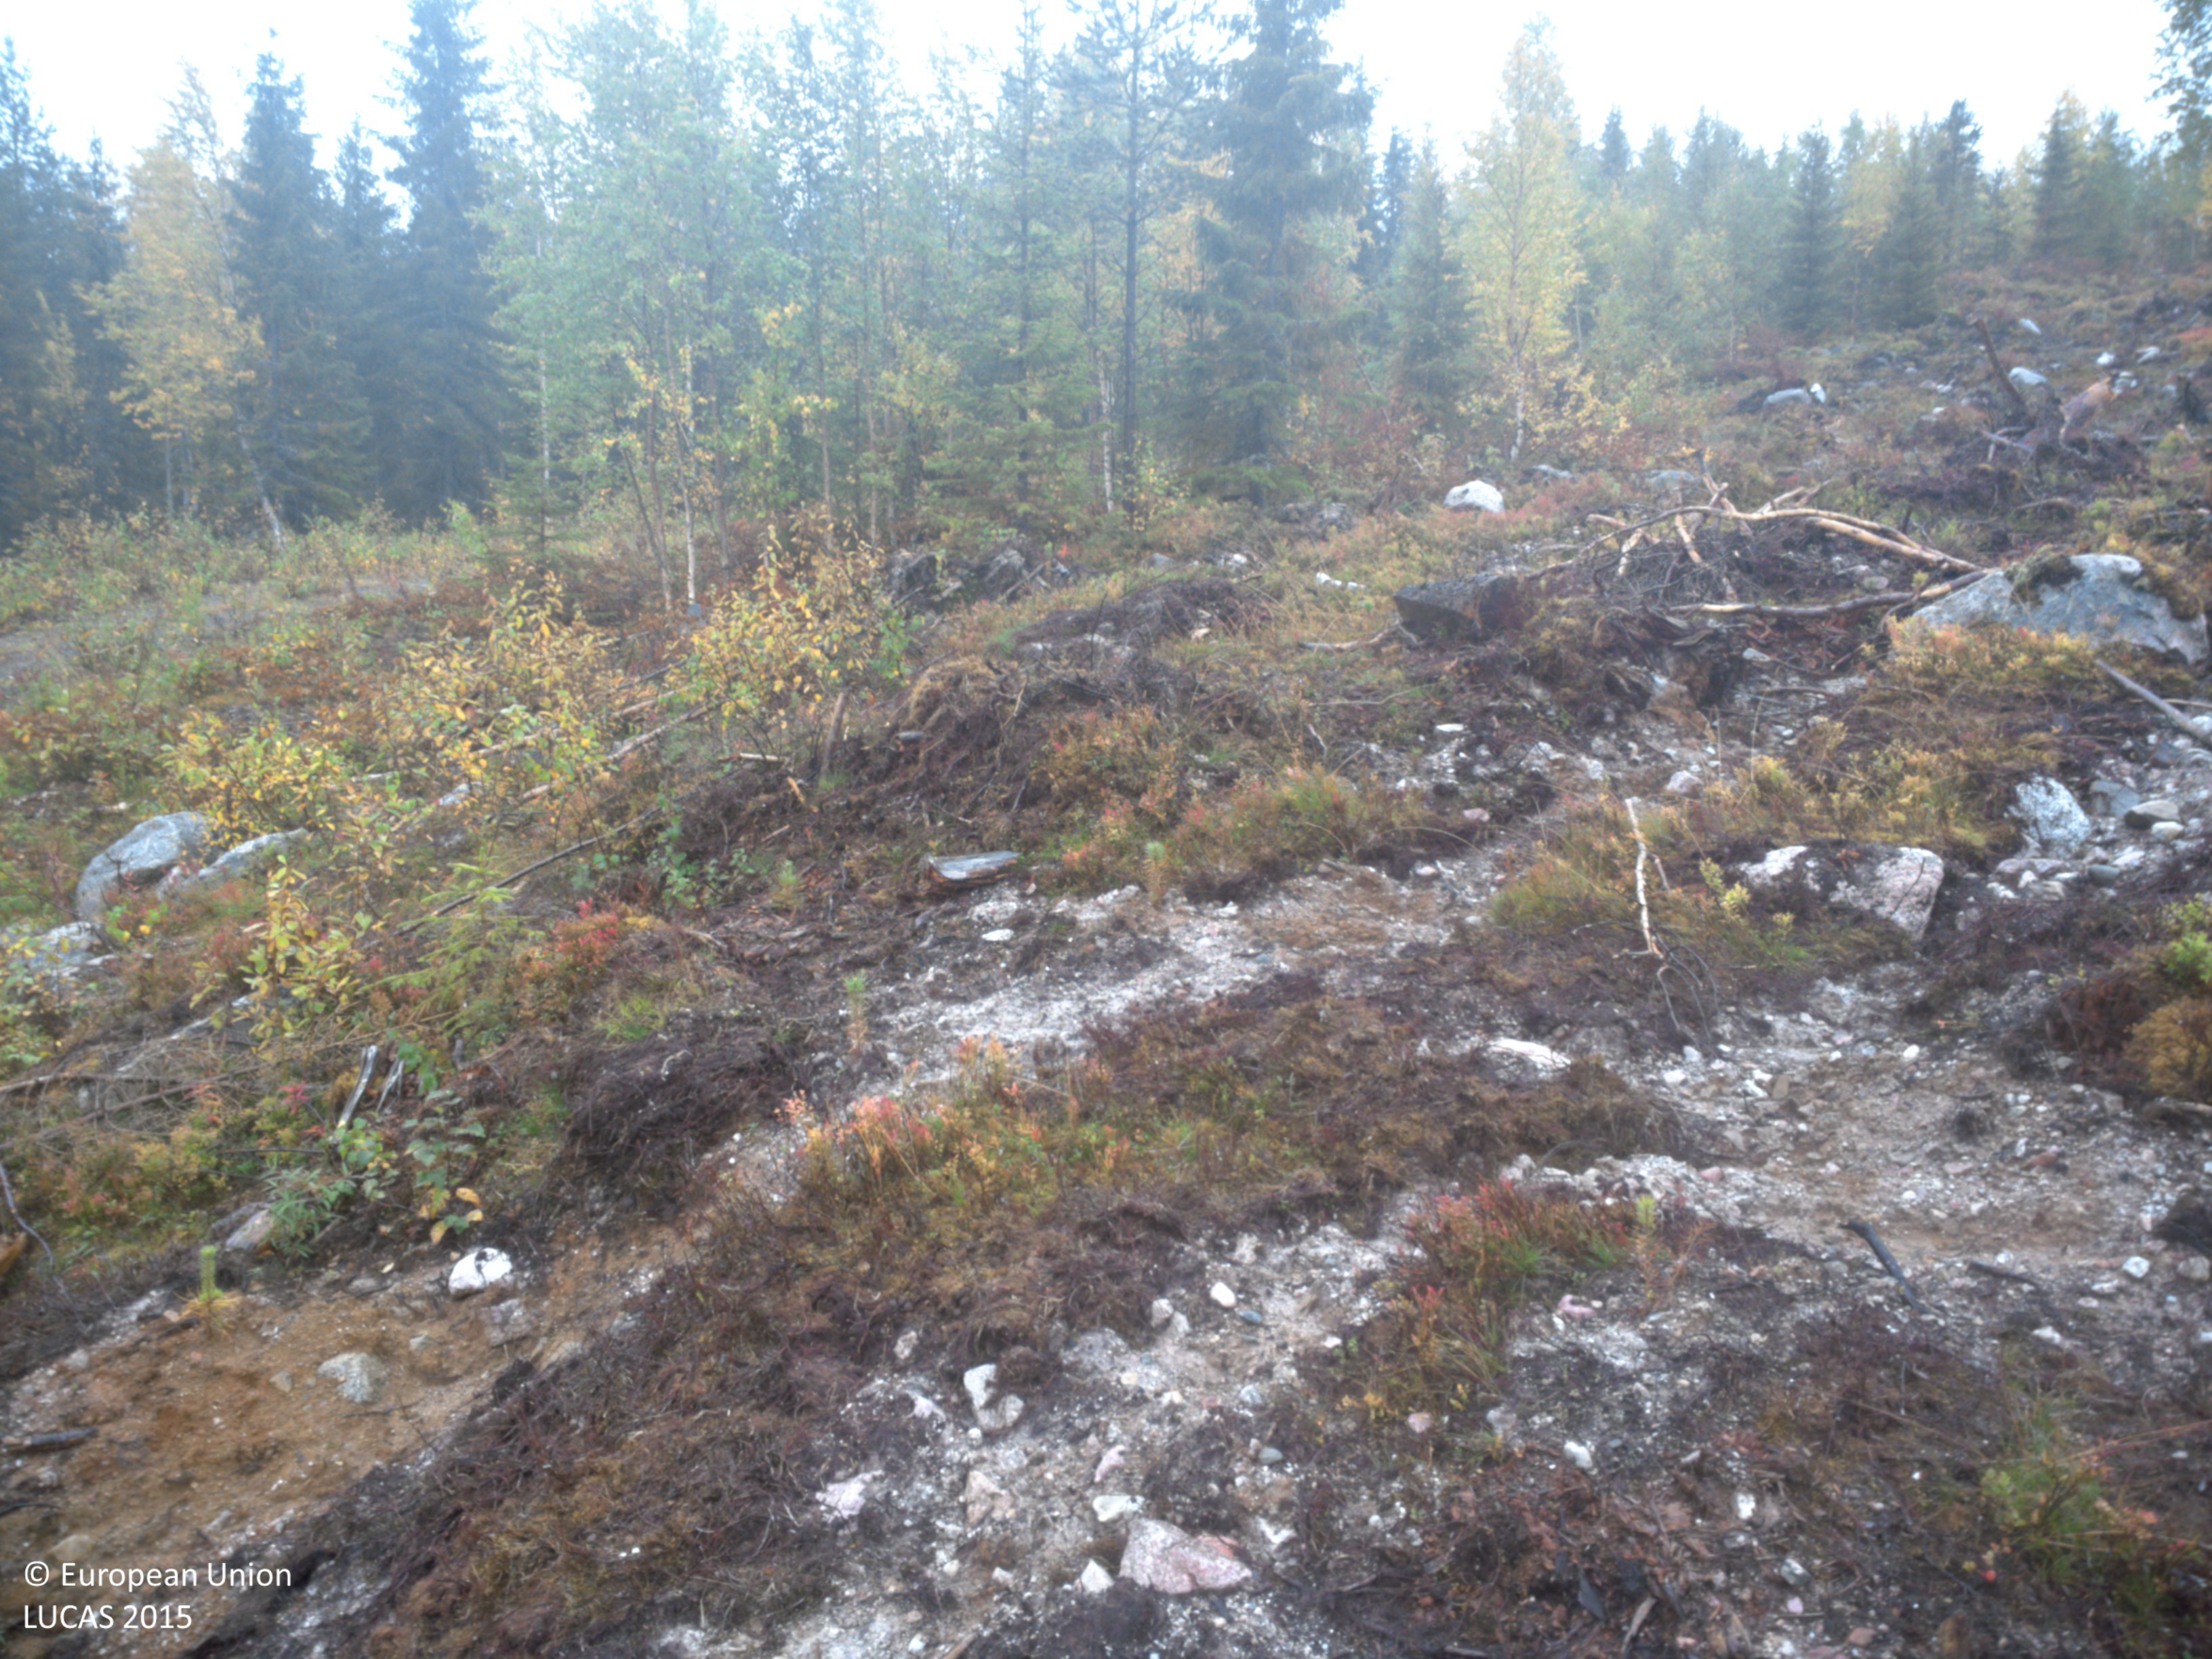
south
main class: Shrubland
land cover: Shrubland with sparse tree cover
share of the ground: 50 - 75 %
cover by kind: shrubs 65 %, unconsolidated bare surface 25 %, coniferous forest trees 5 %, consolidated bare surface 5 %
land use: Forestry
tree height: < 5 m
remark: Clear cut
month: September
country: SE
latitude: 64.8932
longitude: 19.2398
